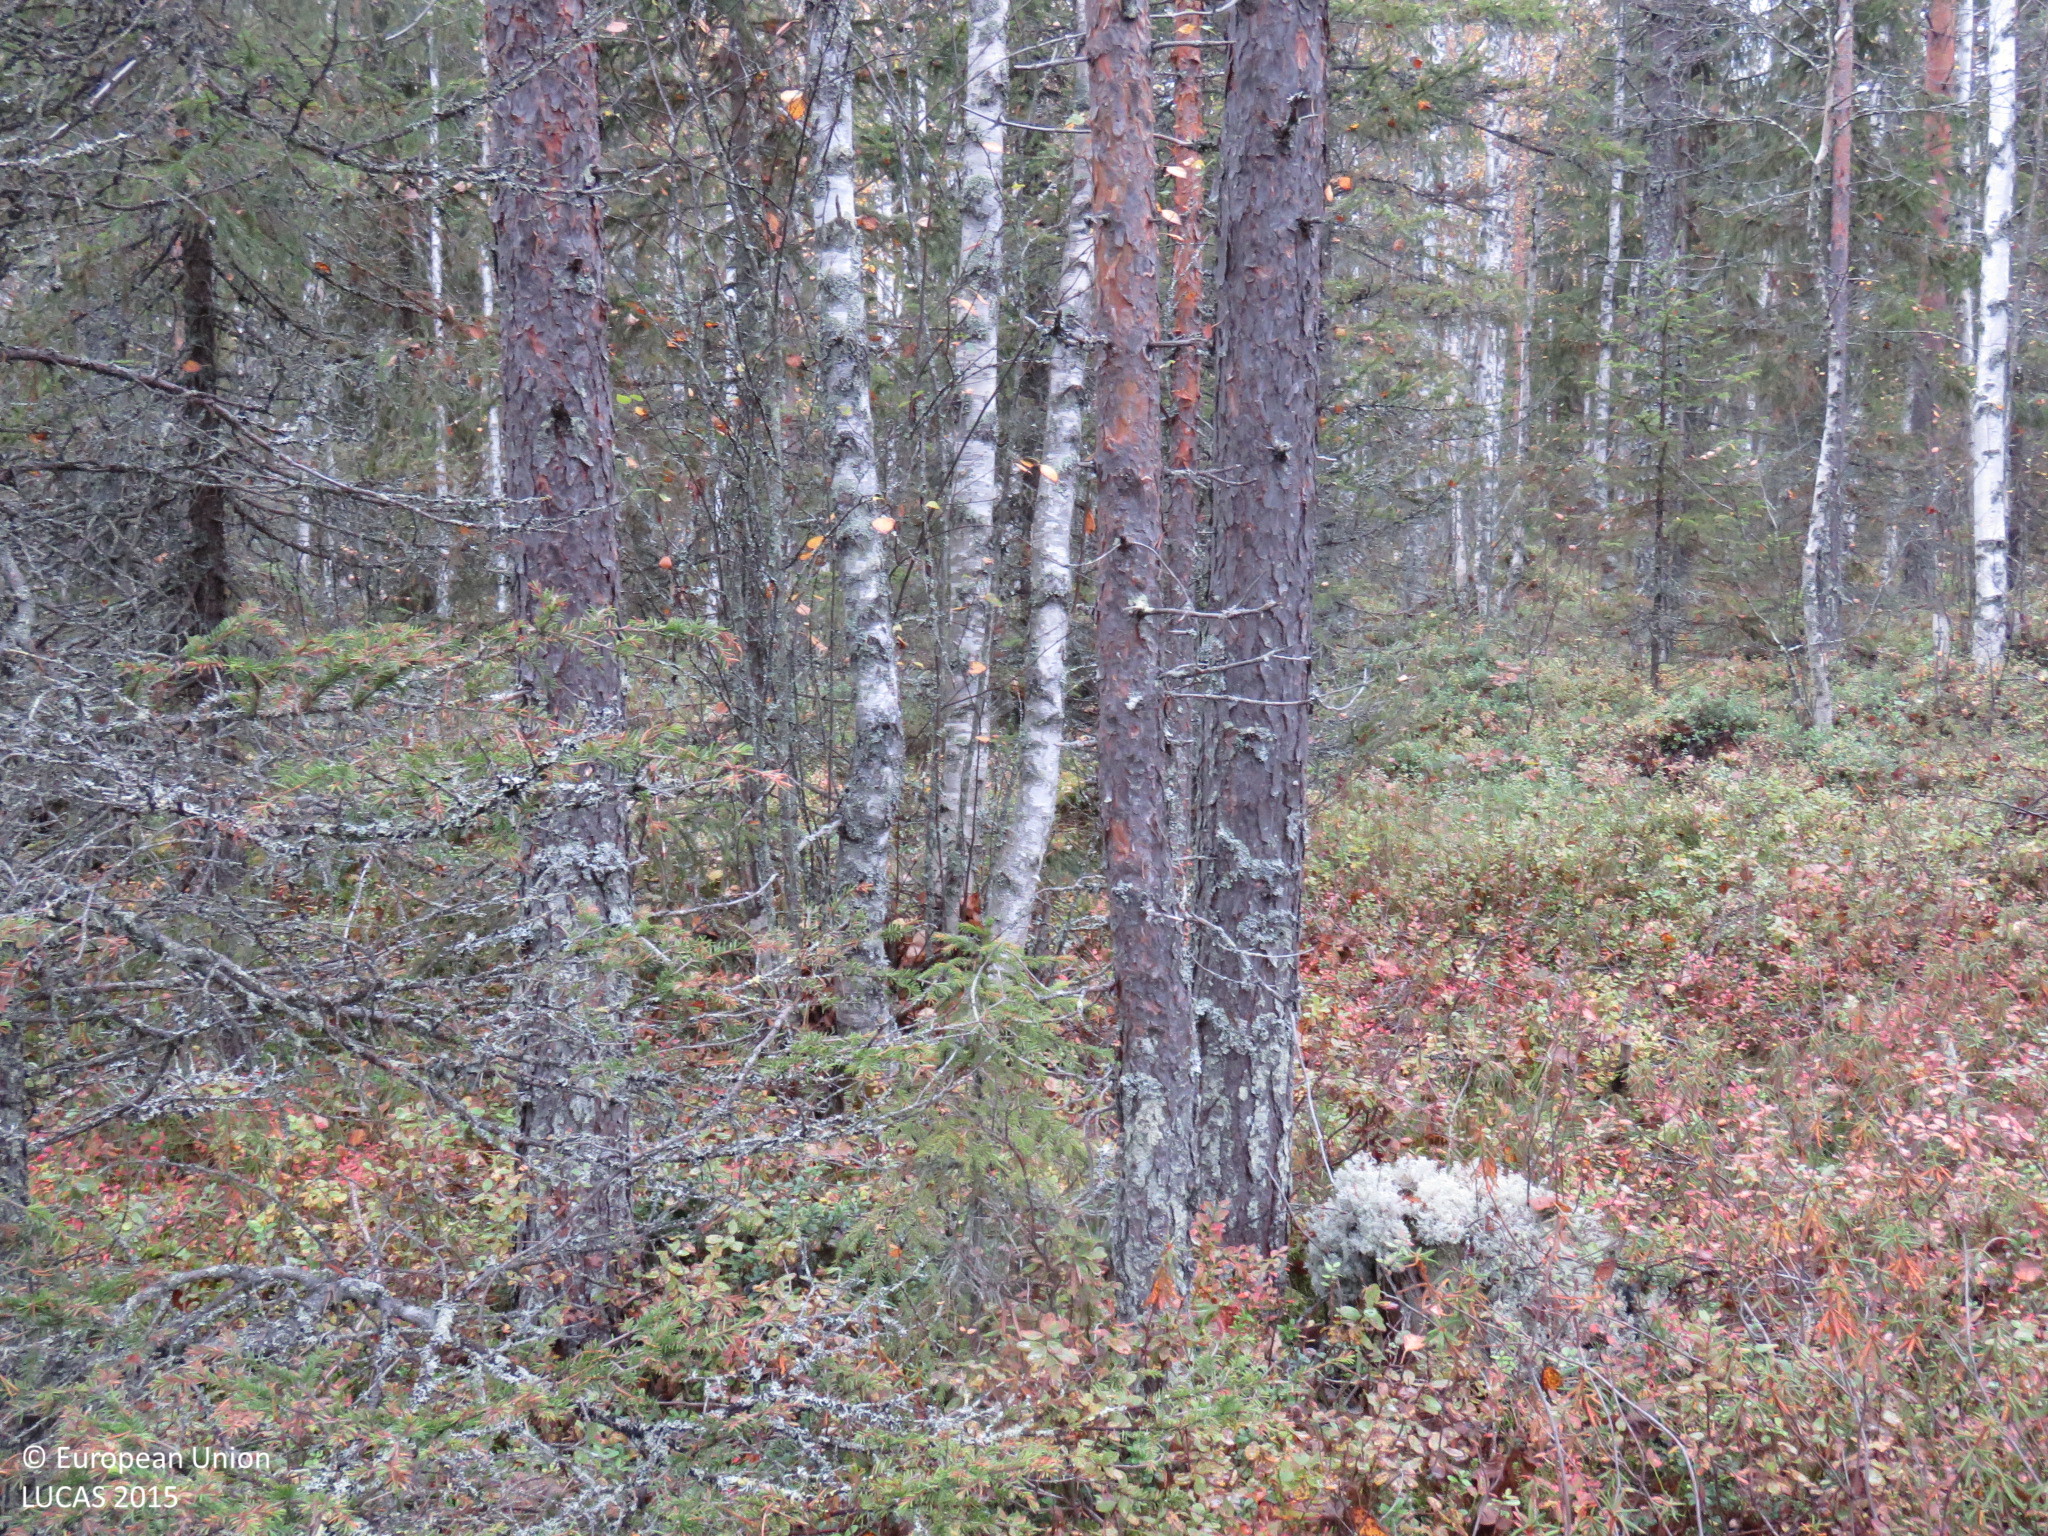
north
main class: Woodland
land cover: Other mixed woodland
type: mire and swamp forests
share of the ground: > 75 %
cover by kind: coniferous forest trees 50 %, broadleaved forest trees 25 %, shrubs 10 %, lichens and mosses 10 %, herbaceous plants 5 %
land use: Forestry
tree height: > 5 m
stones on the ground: < 10 %
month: September
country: FI
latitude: 64.8395
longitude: 27.0529
